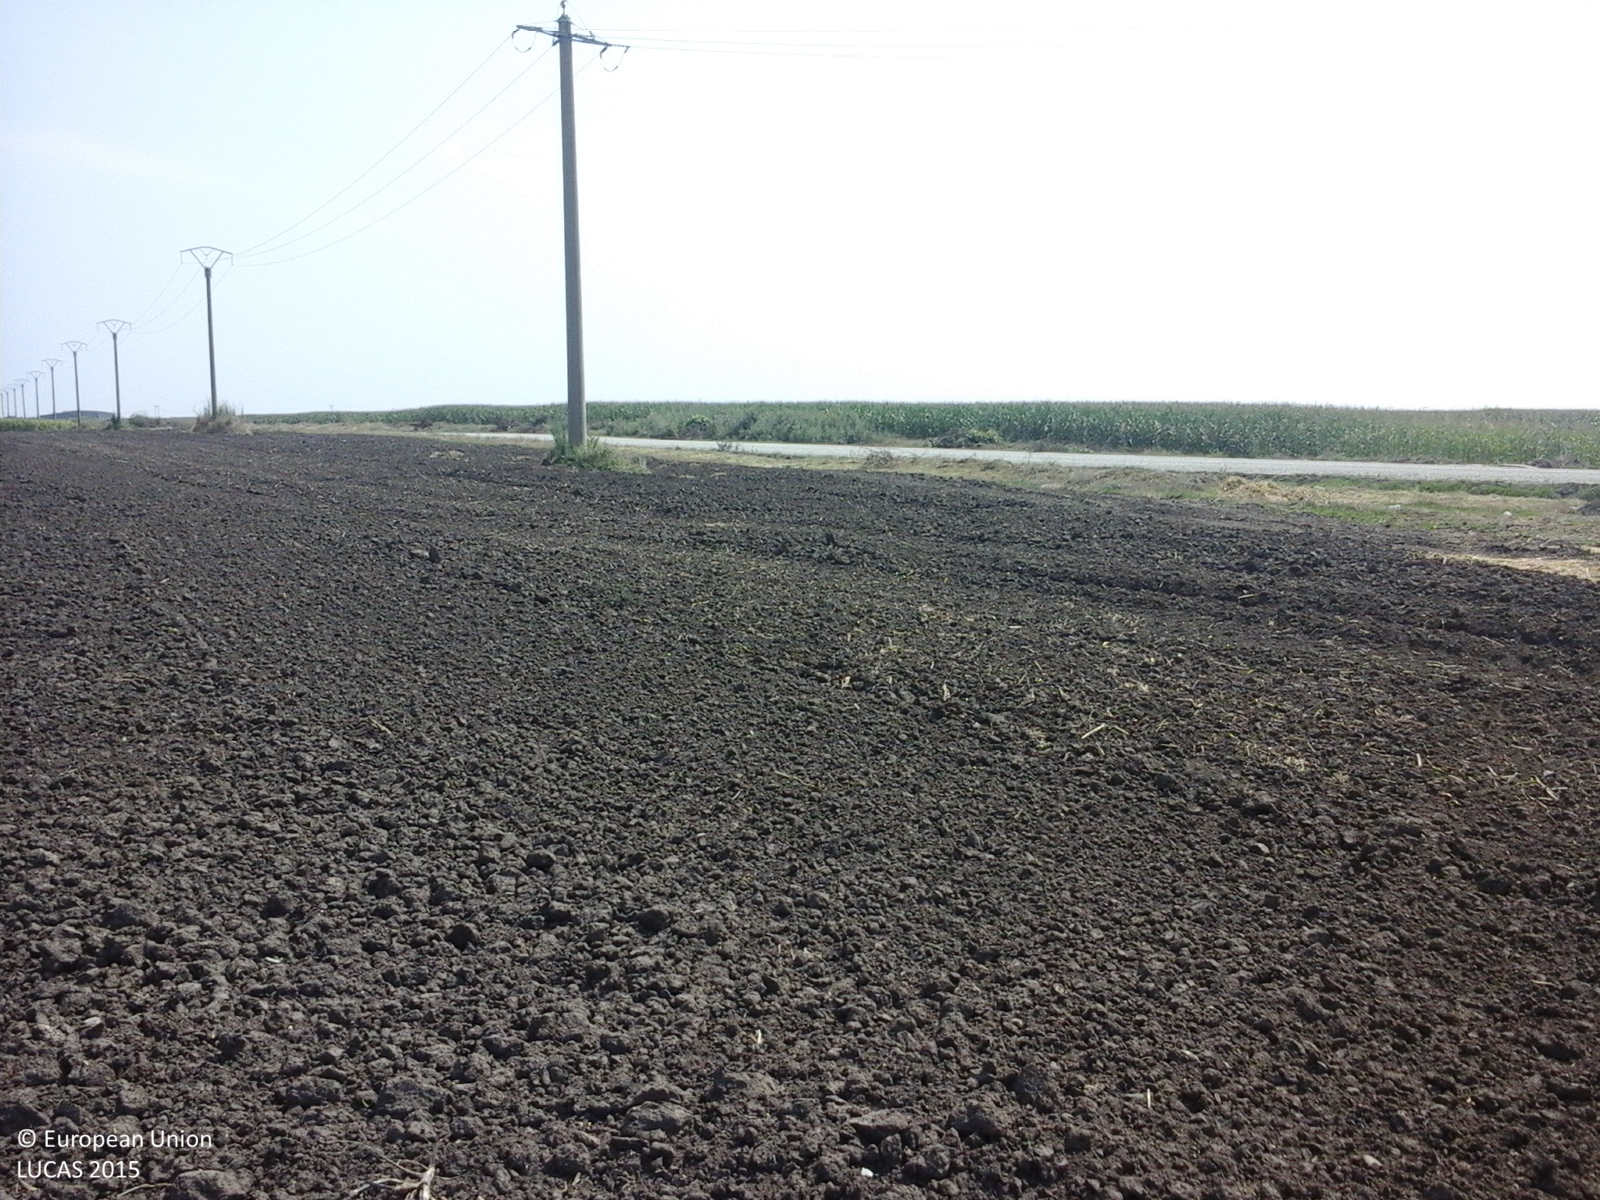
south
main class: Cropland
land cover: Common wheat
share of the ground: < 10 %
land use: Agriculture (excluding fallow land and kitchen gardens)
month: July
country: RO
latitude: 44.5716
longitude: 26.7836
